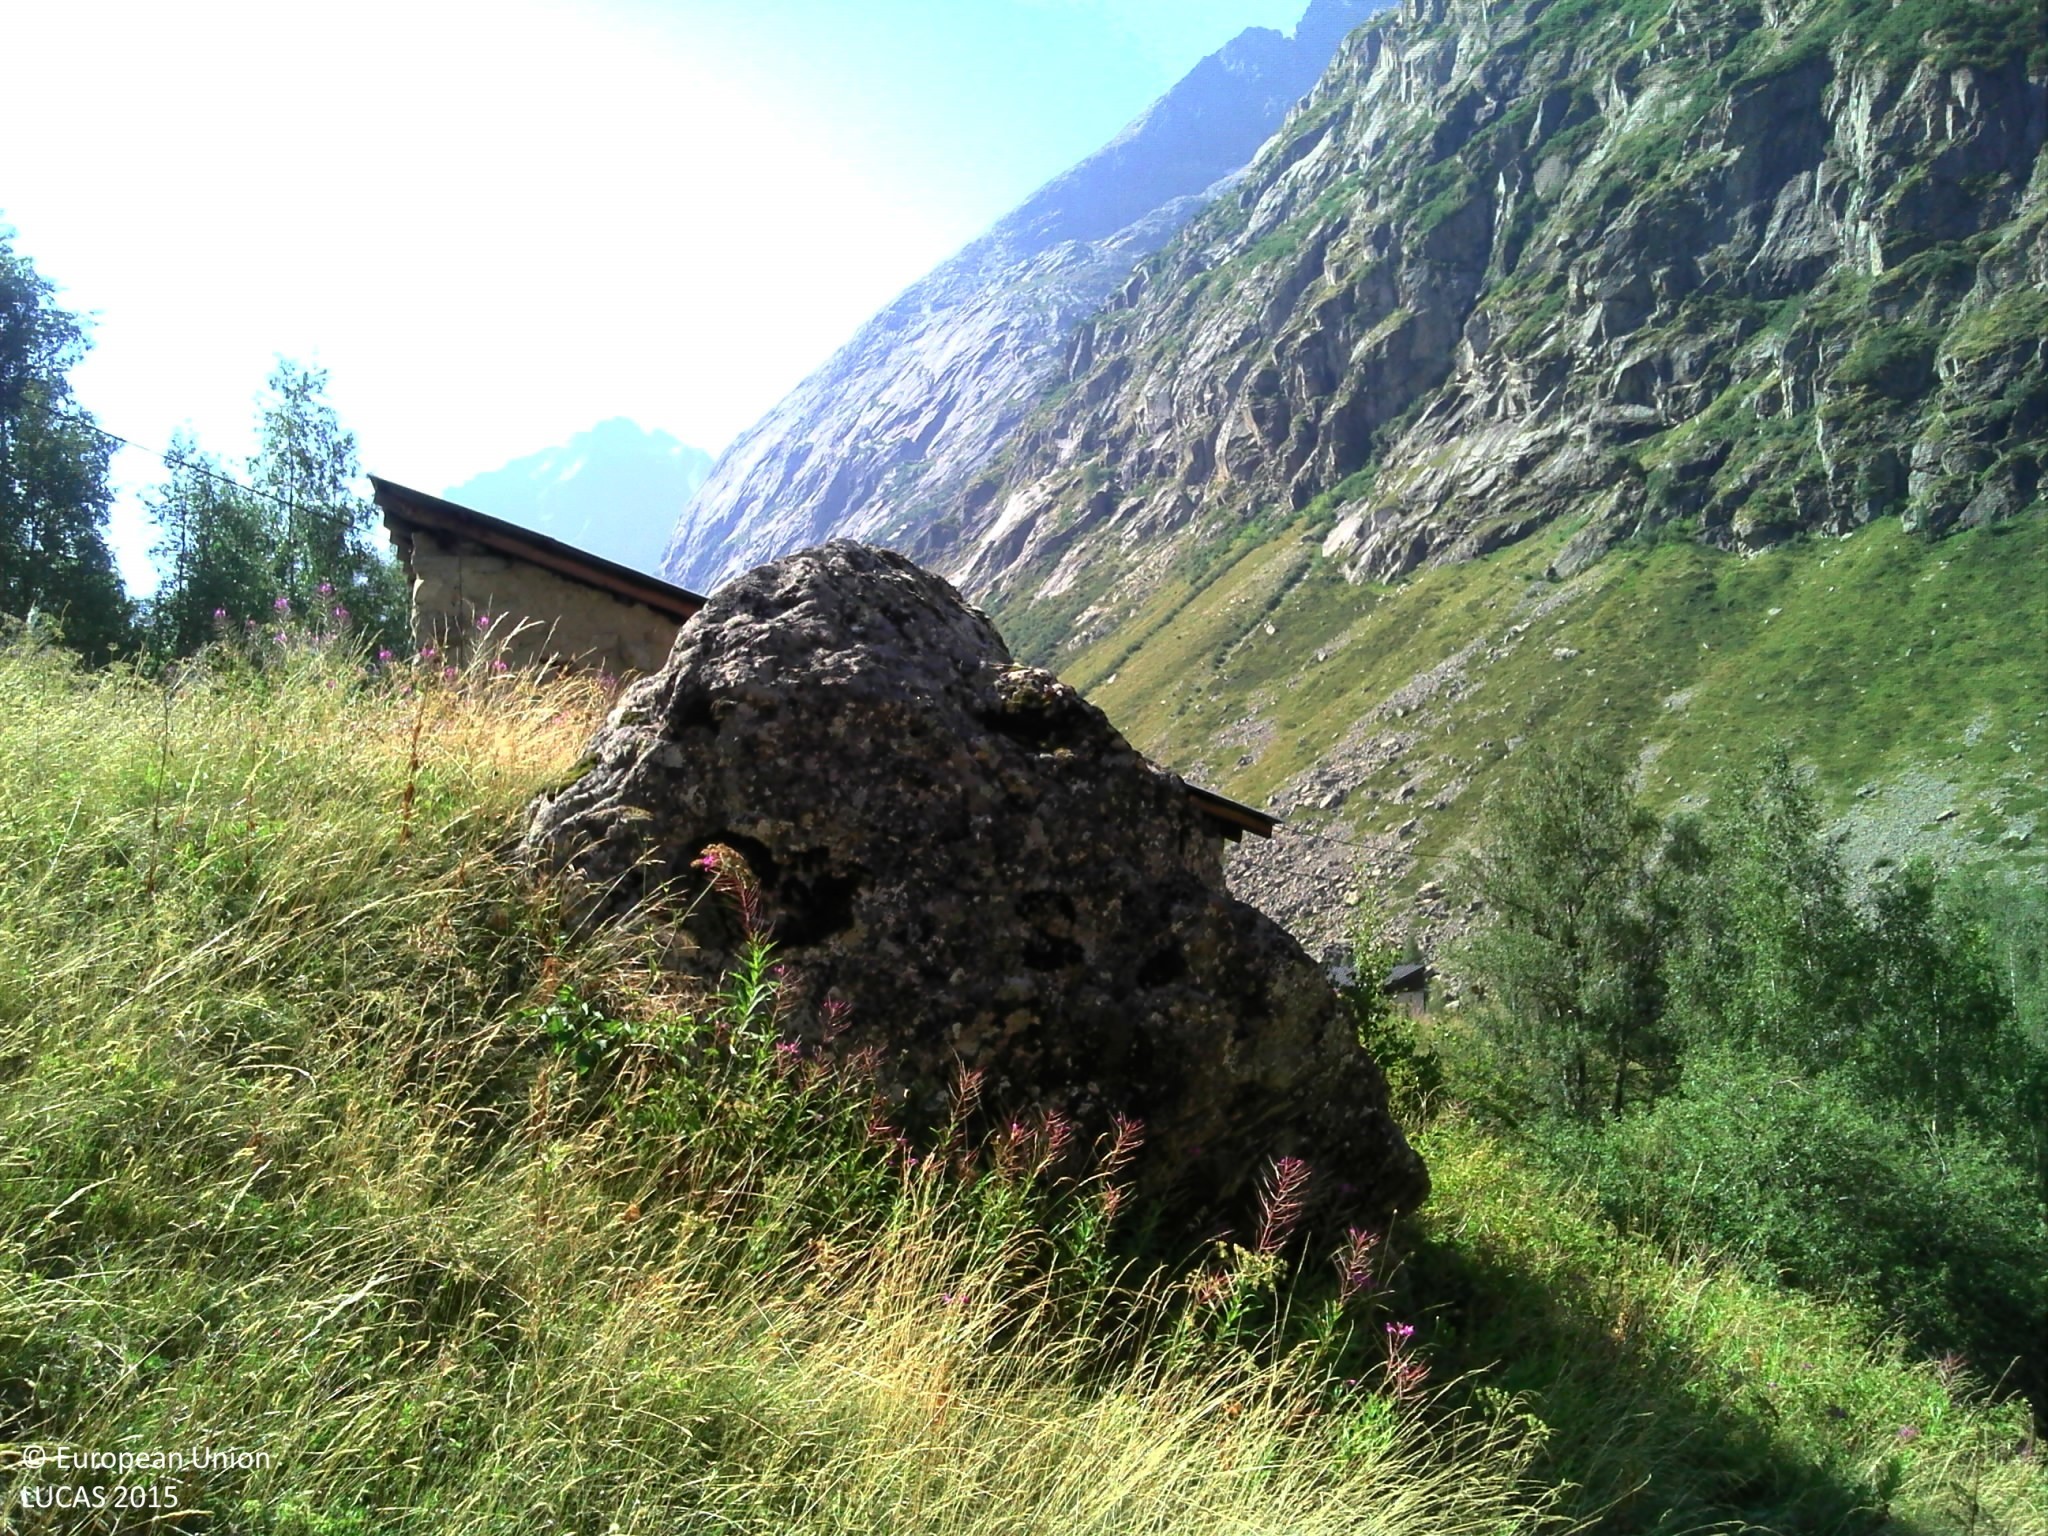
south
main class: Grassland
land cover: Grassland without tree/shrub cover
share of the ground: > 75 %
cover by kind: herbaceous plants 90 %, shrubs 5 %, unconsolidated bare surface 5 %
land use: Semi-natural and natural areas not in use
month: August
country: FR
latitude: 44.9342
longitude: 6.2930
